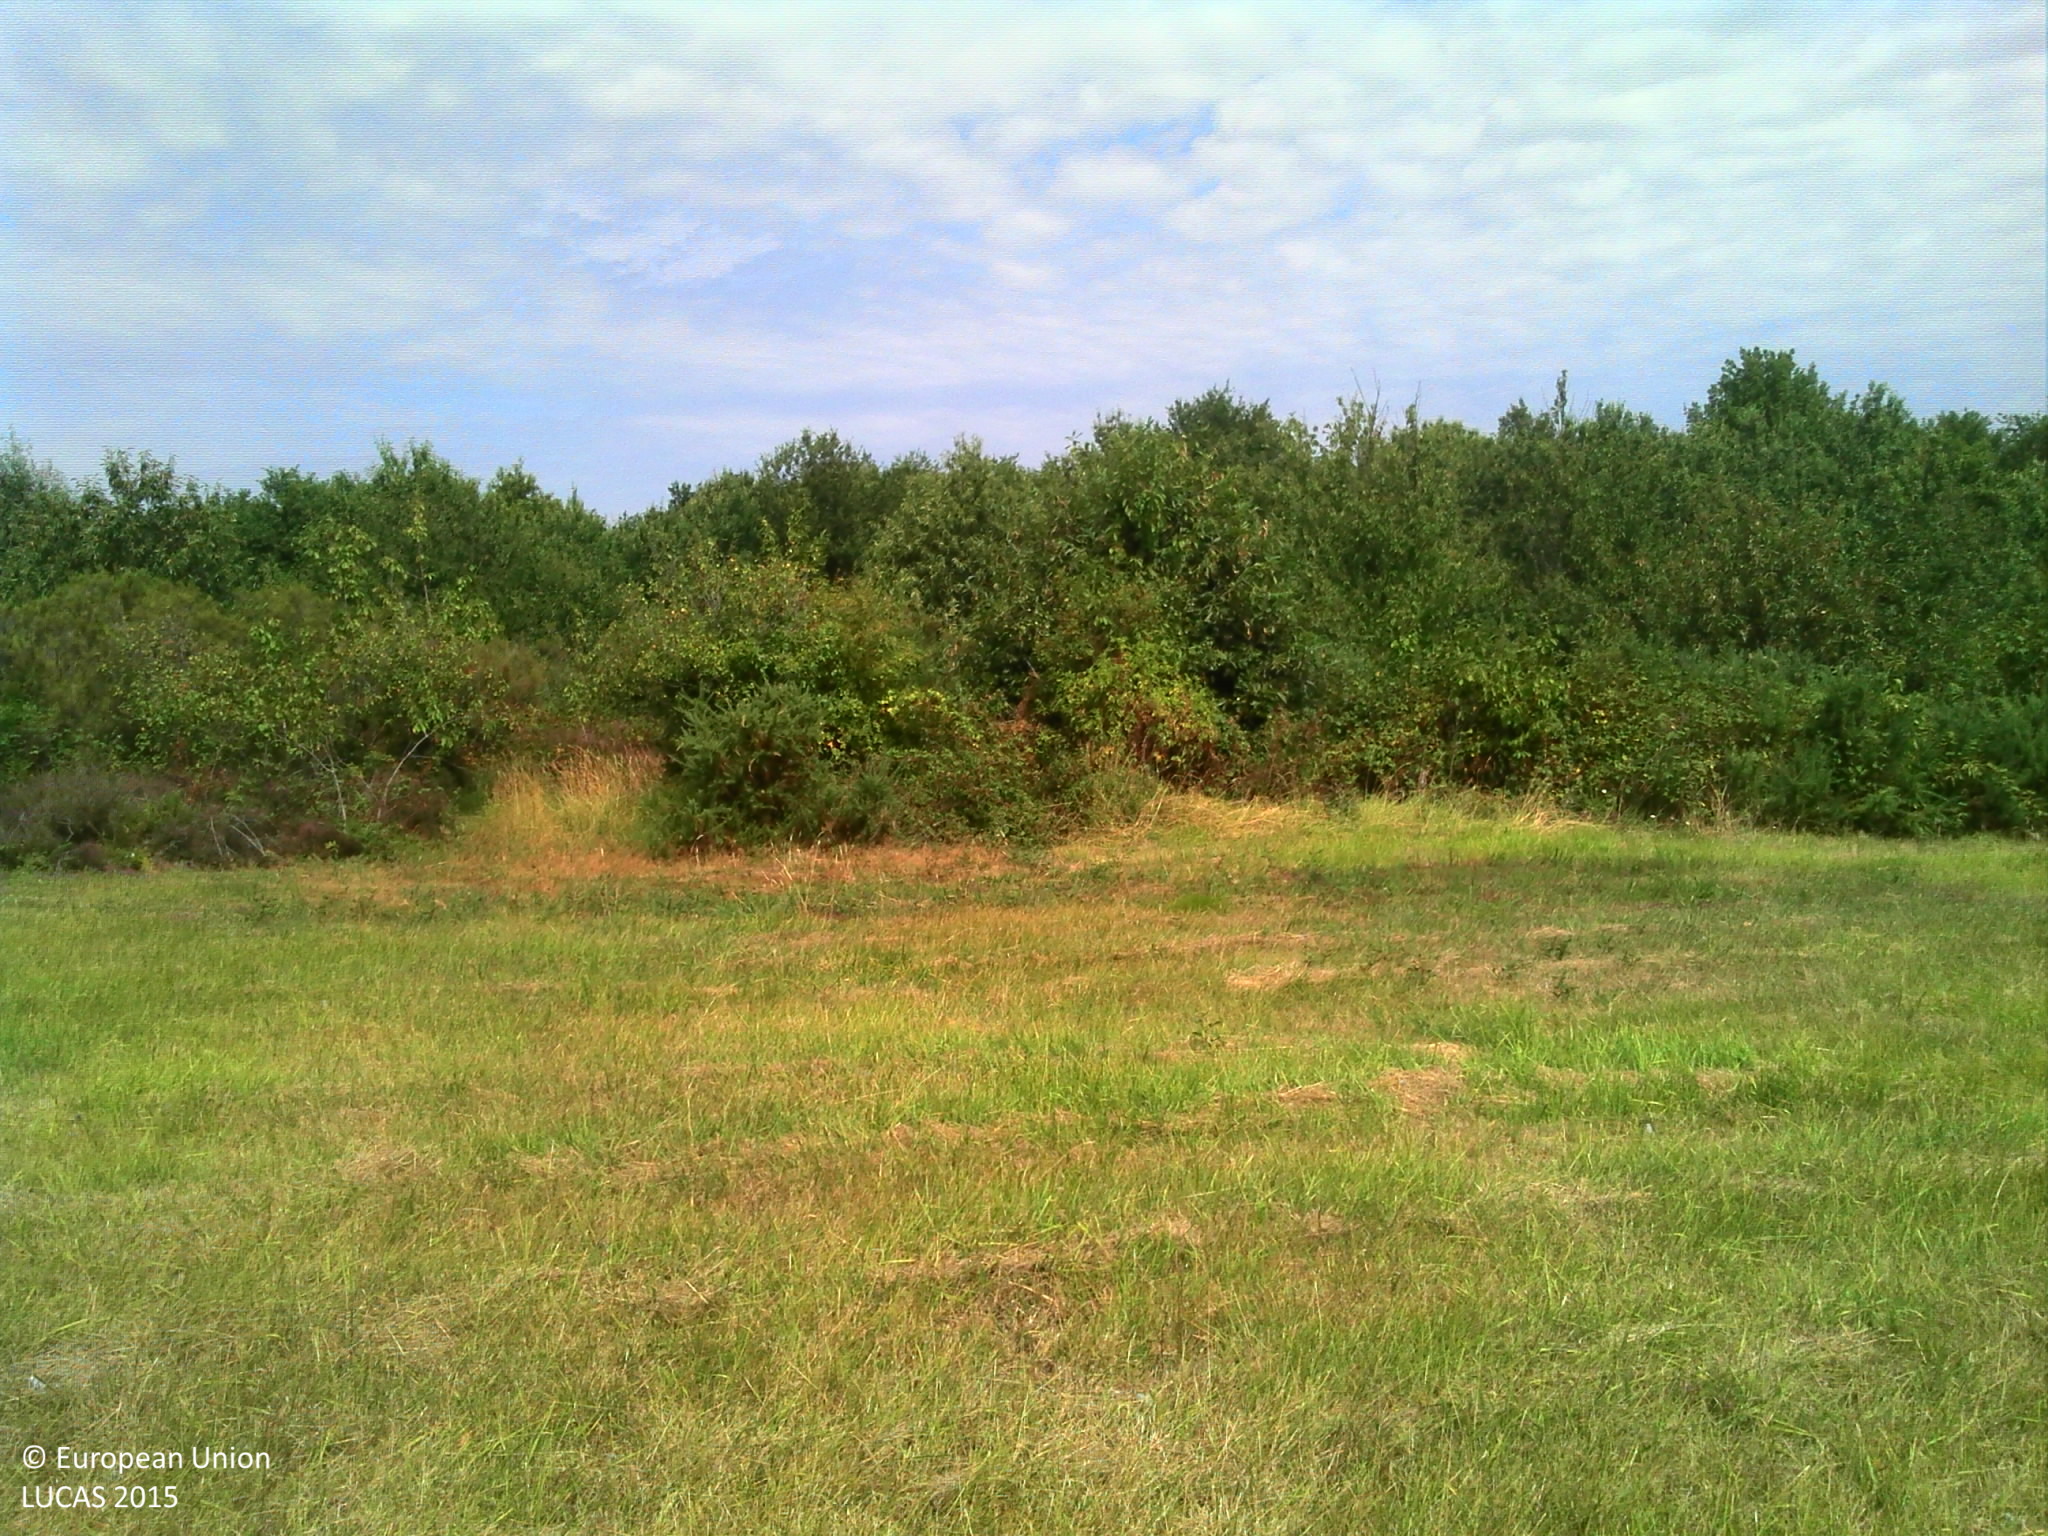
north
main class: Grassland
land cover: Grassland without tree/shrub cover
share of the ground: > 75 %
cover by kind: herbaceous plants 95 %, shrubs 5 %
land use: Sport
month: August
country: FR
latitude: 47.1495
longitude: 0.1785
